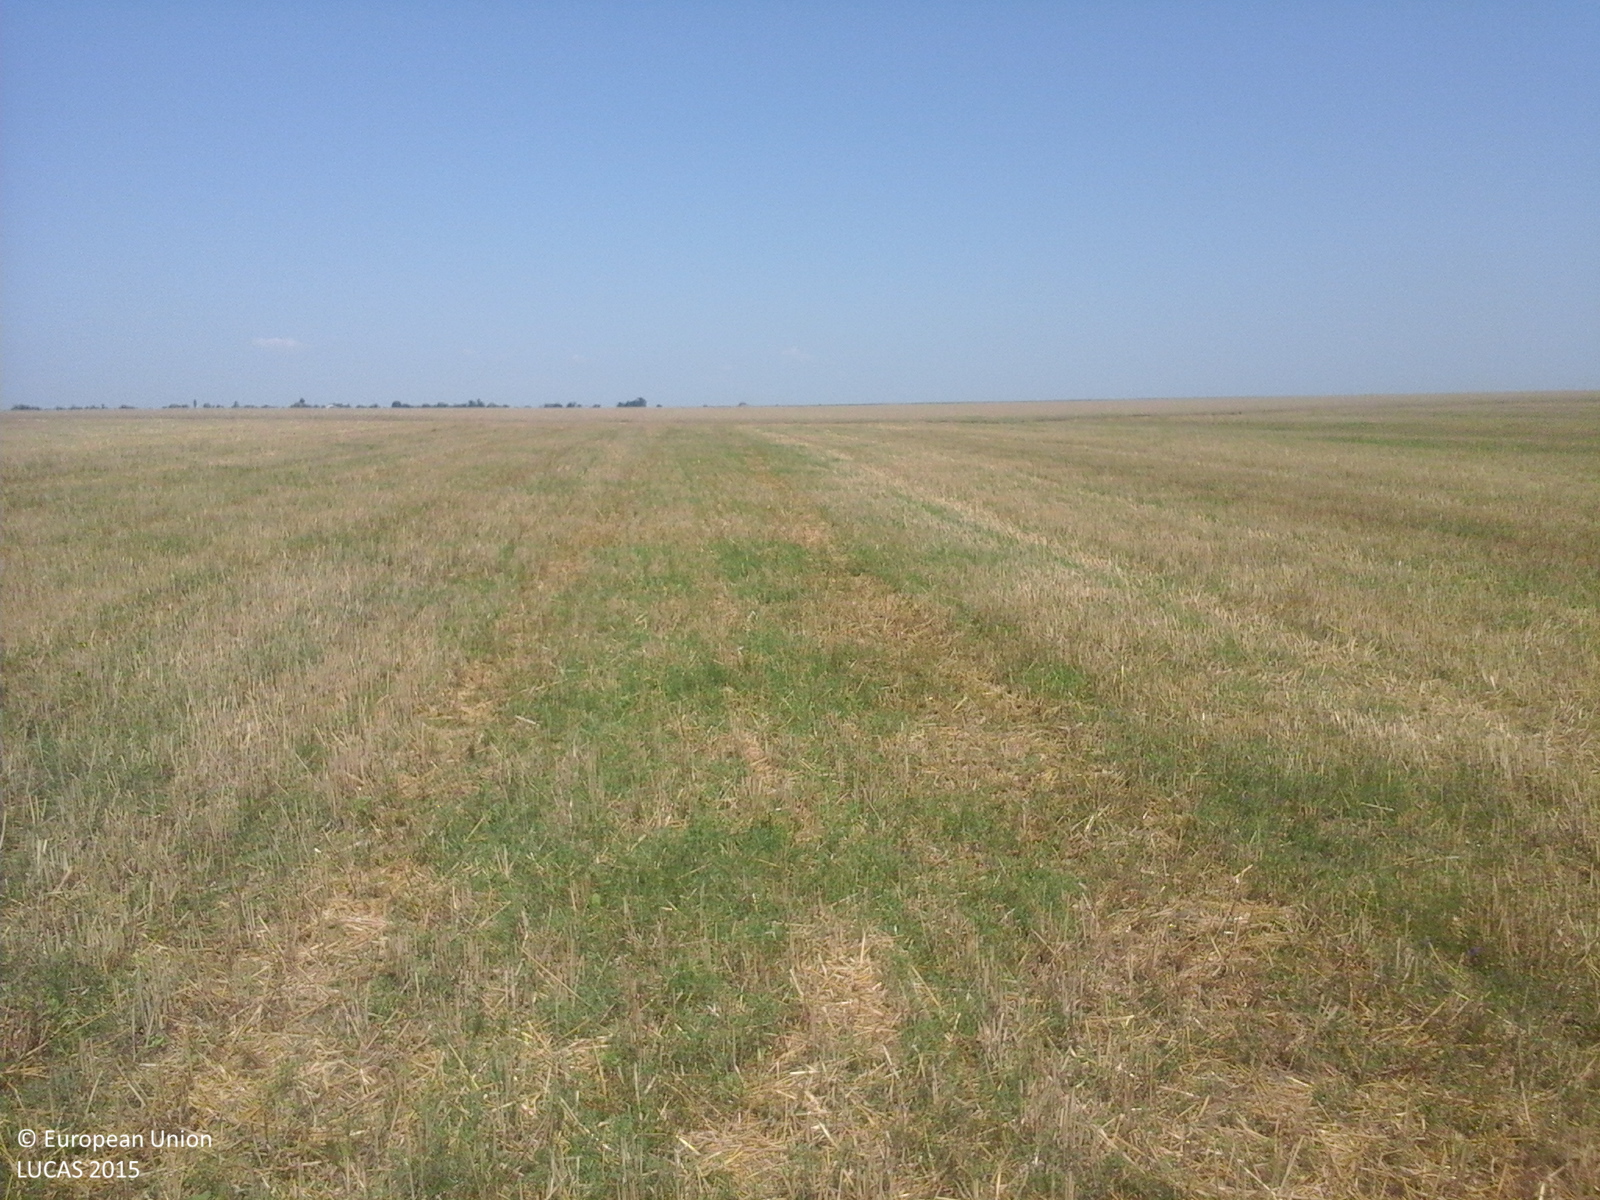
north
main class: Cropland
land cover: Common wheat
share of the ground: < 10 %
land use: Agriculture (excluding fallow land and kitchen gardens)
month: July
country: RO
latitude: 44.1802
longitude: 24.6692
